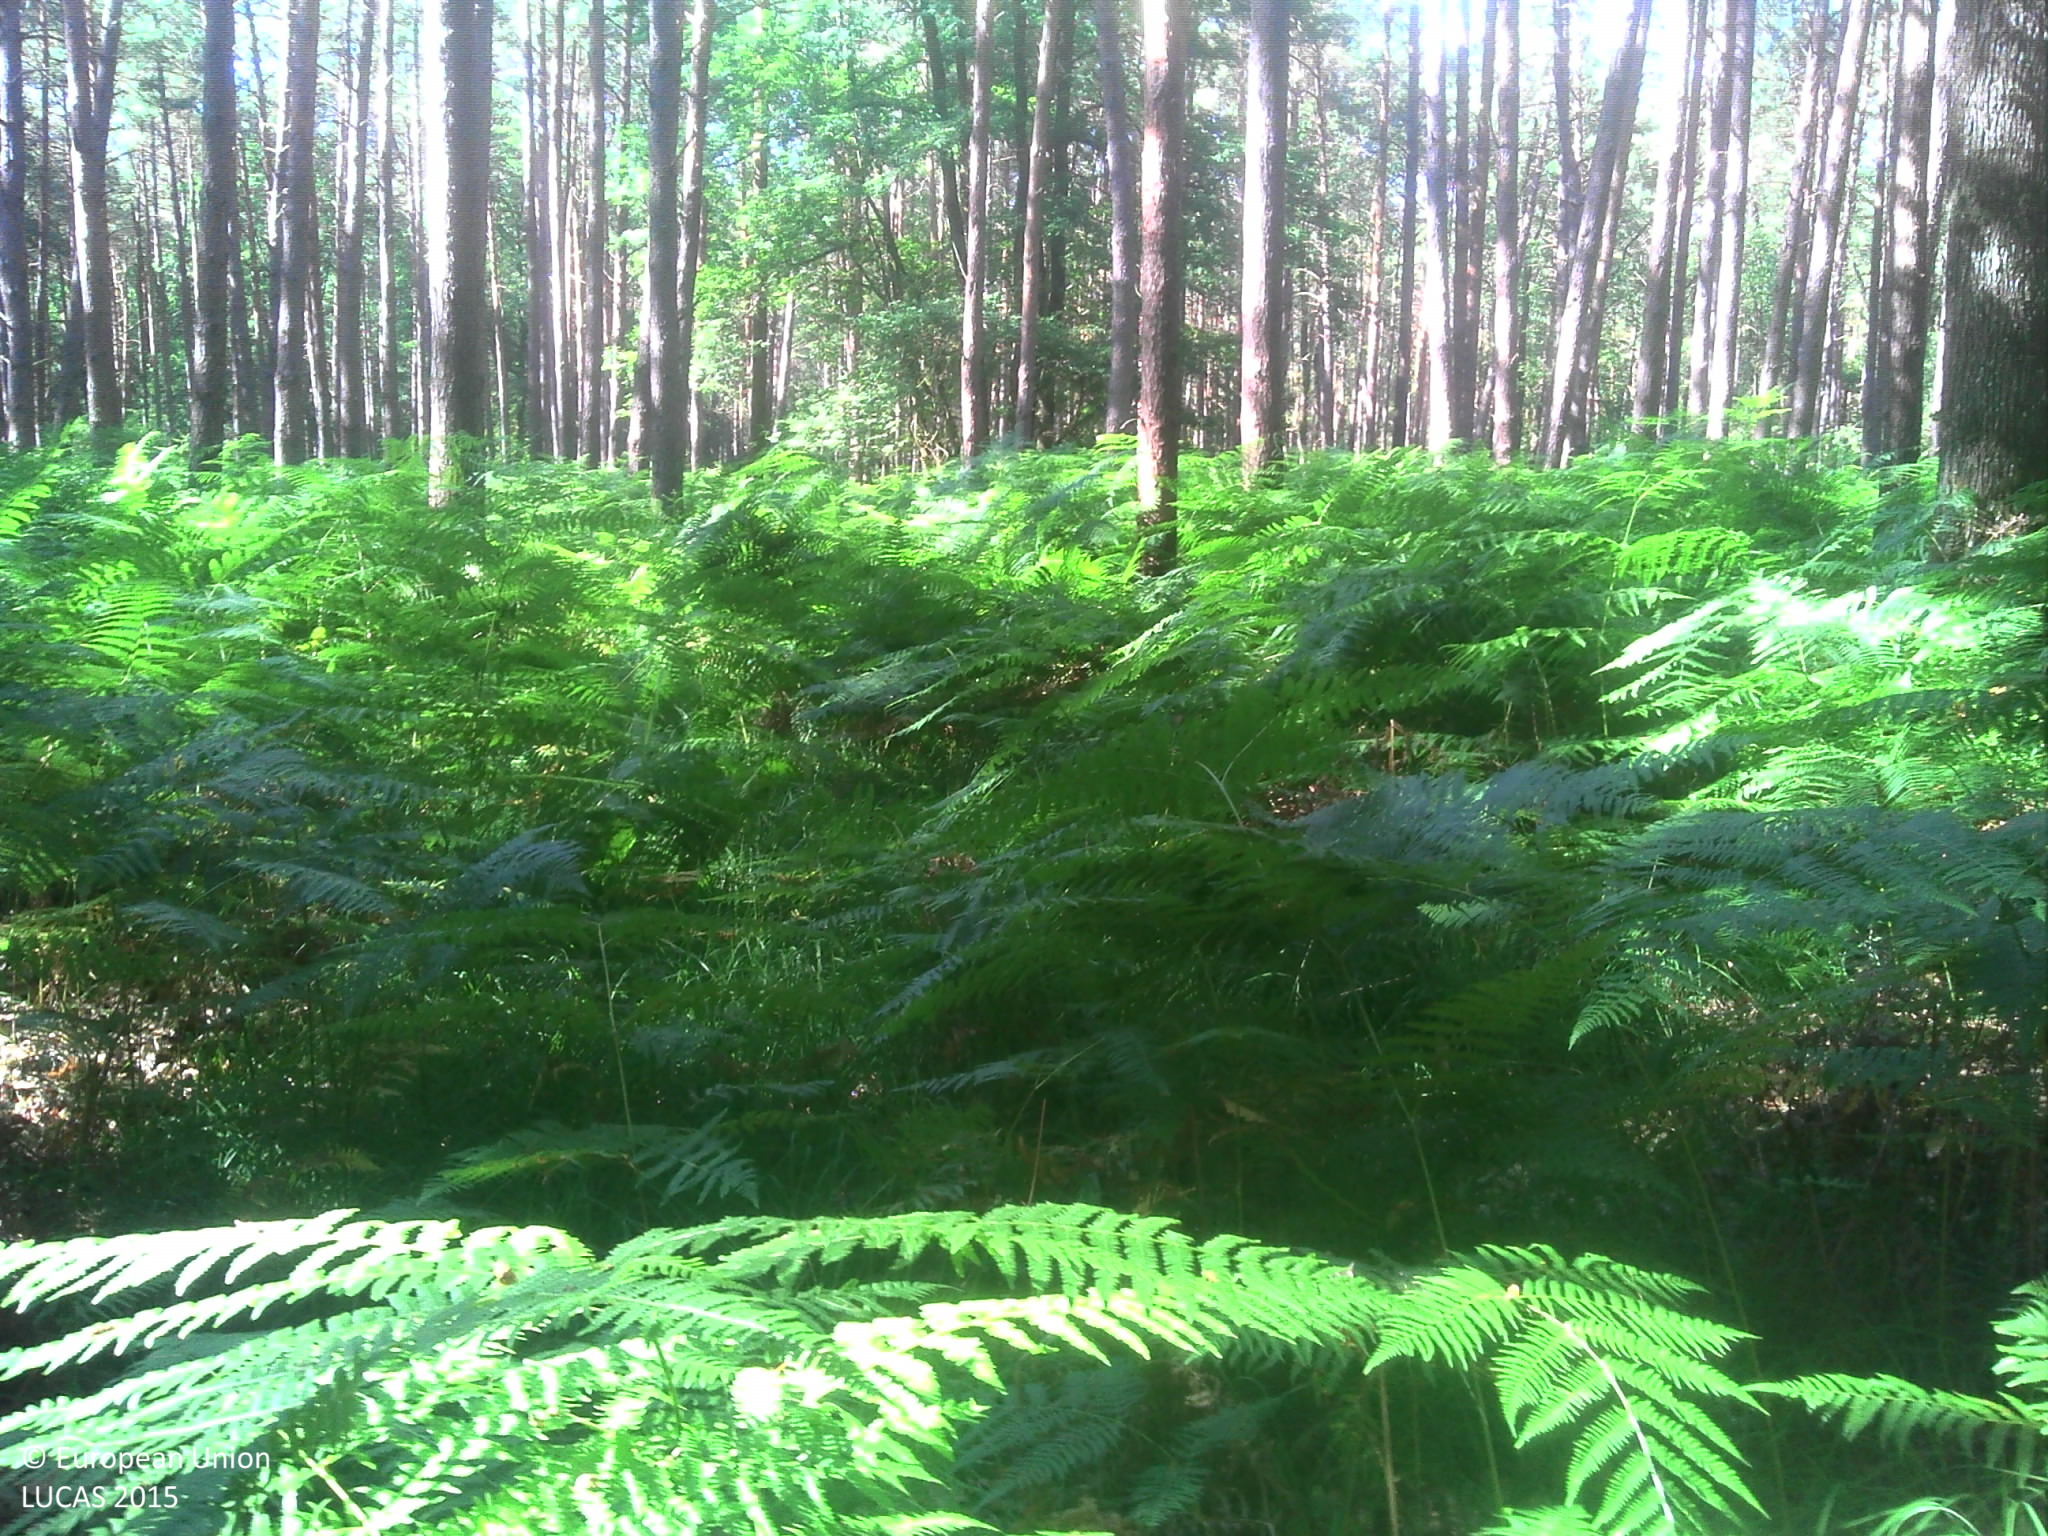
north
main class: Woodland
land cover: Pine dominated mixed woodland
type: thermophilous deciduous forest
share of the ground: > 75 %
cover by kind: herbaceous plants 40 %, unconsolidated bare surface 35 %, coniferous forest trees 15 %, broadleaved forest trees 10 %
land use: Forestry
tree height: > 5 m
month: June
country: FR
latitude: 47.3101
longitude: 1.4280
